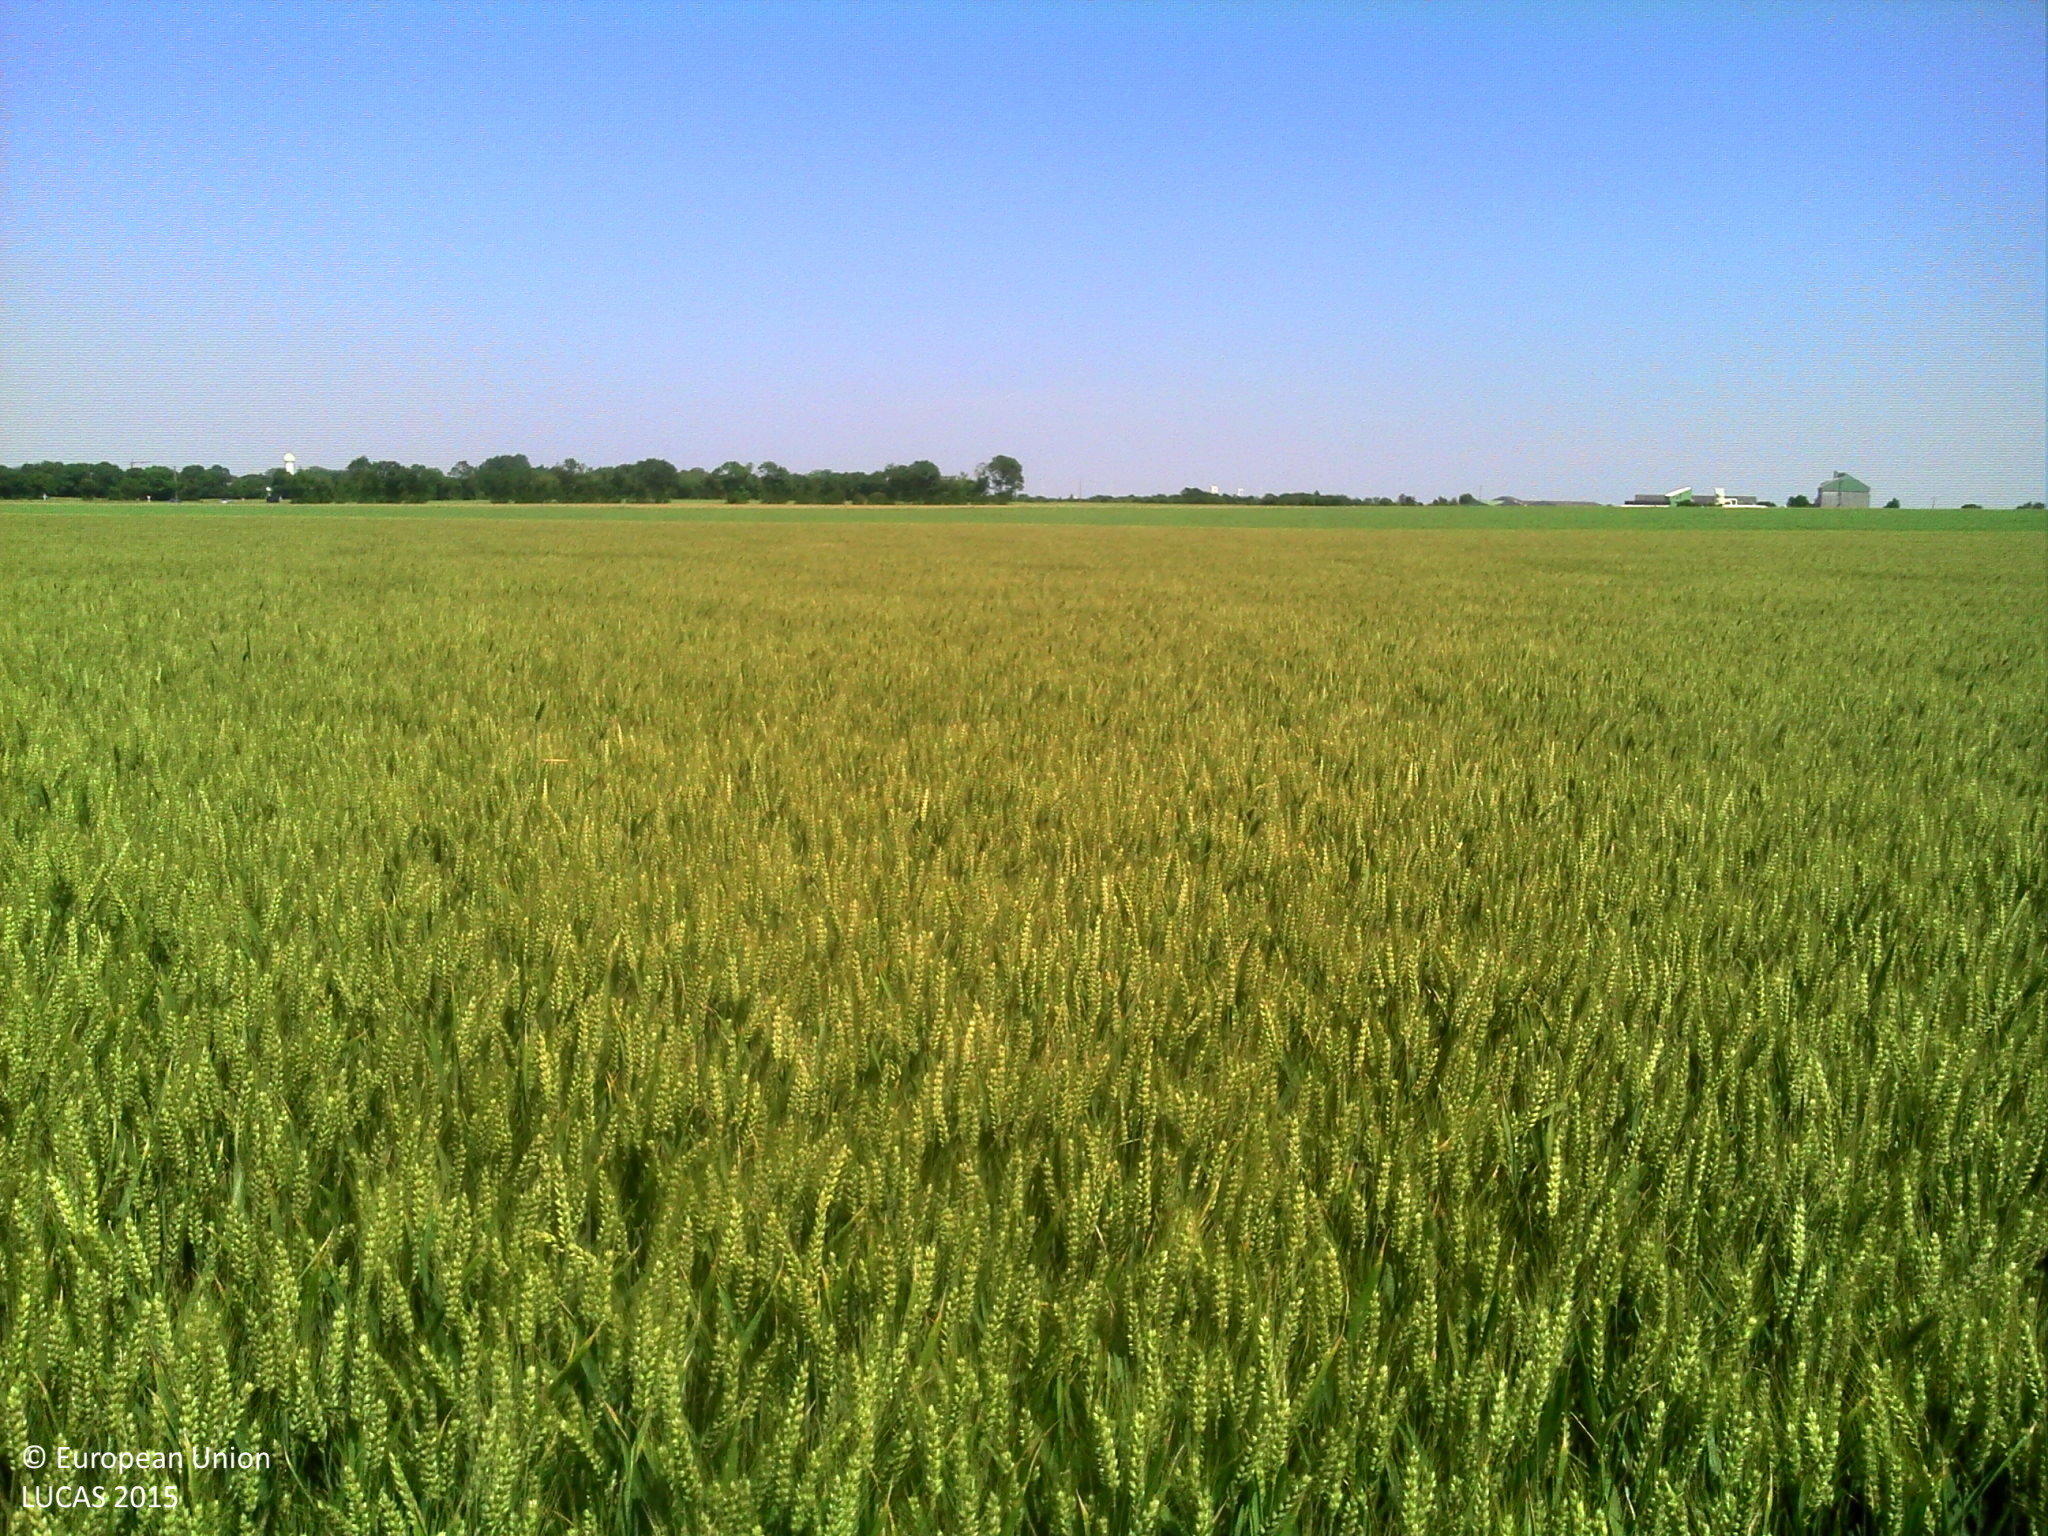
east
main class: Cropland
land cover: Durum wheat
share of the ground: > 75 %
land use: Agriculture (excluding fallow land and kitchen gardens)
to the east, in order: Durum wheat; Dry pulses
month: June
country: FR
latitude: 46.1130
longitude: -0.9628
